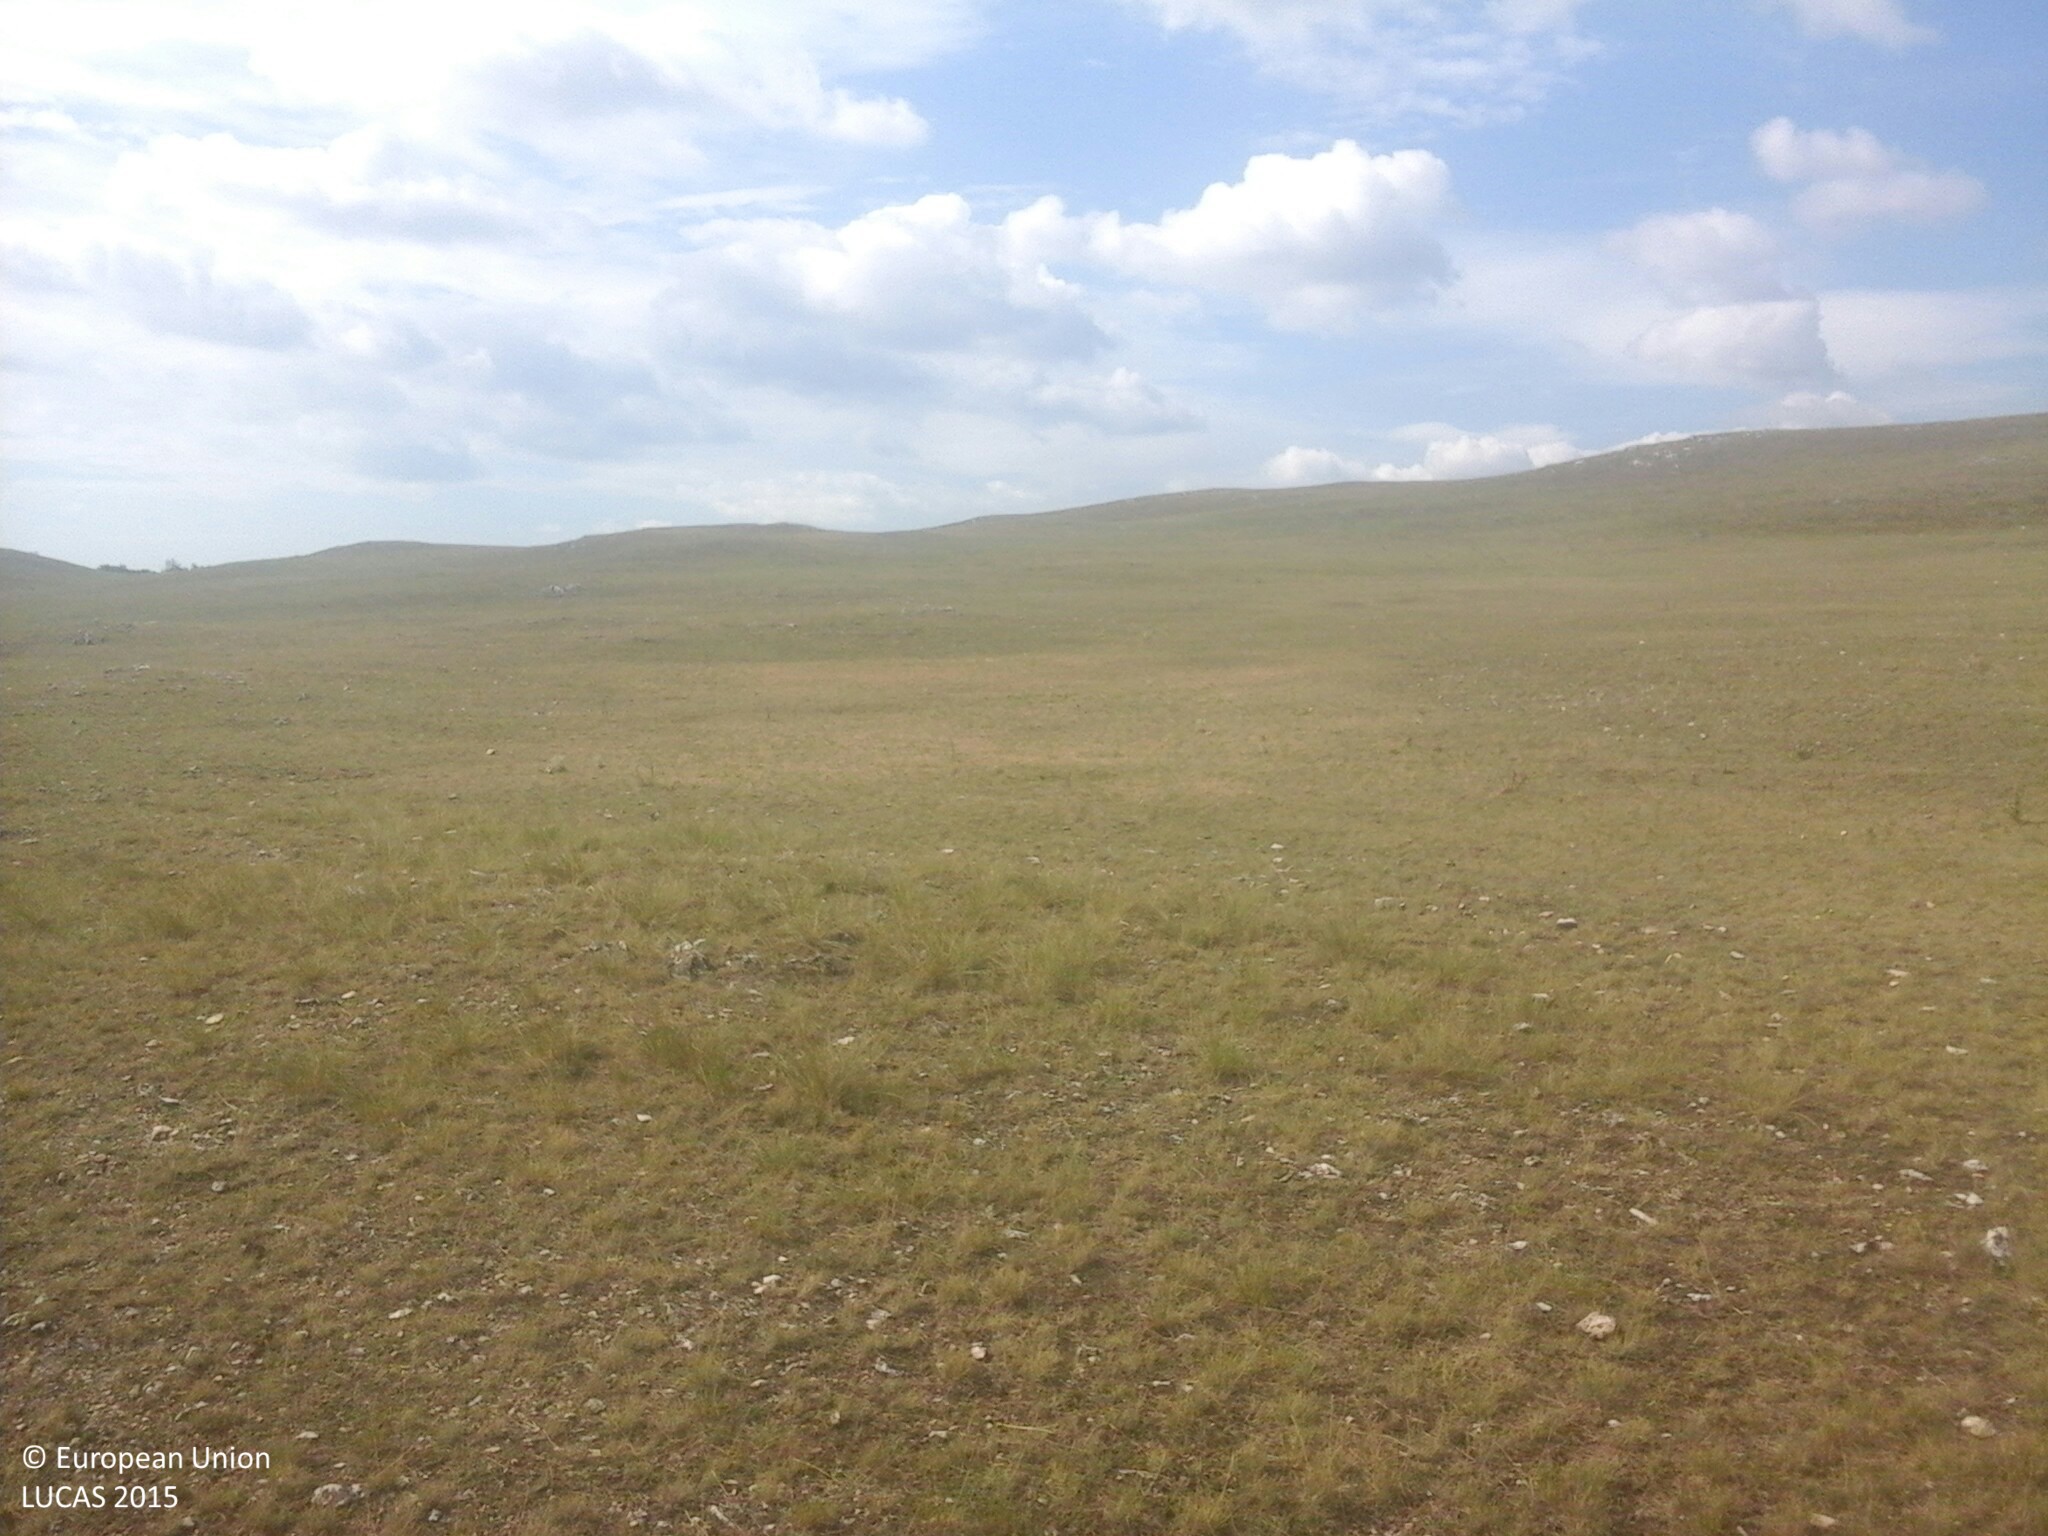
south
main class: Grassland
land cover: Grassland without tree/shrub cover
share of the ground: > 75 %
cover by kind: herbaceous plants 80 %, consolidated bare surface 20 %
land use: Semi-natural and natural areas not in use
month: July
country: HU
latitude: 47.1358
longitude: 18.0127
